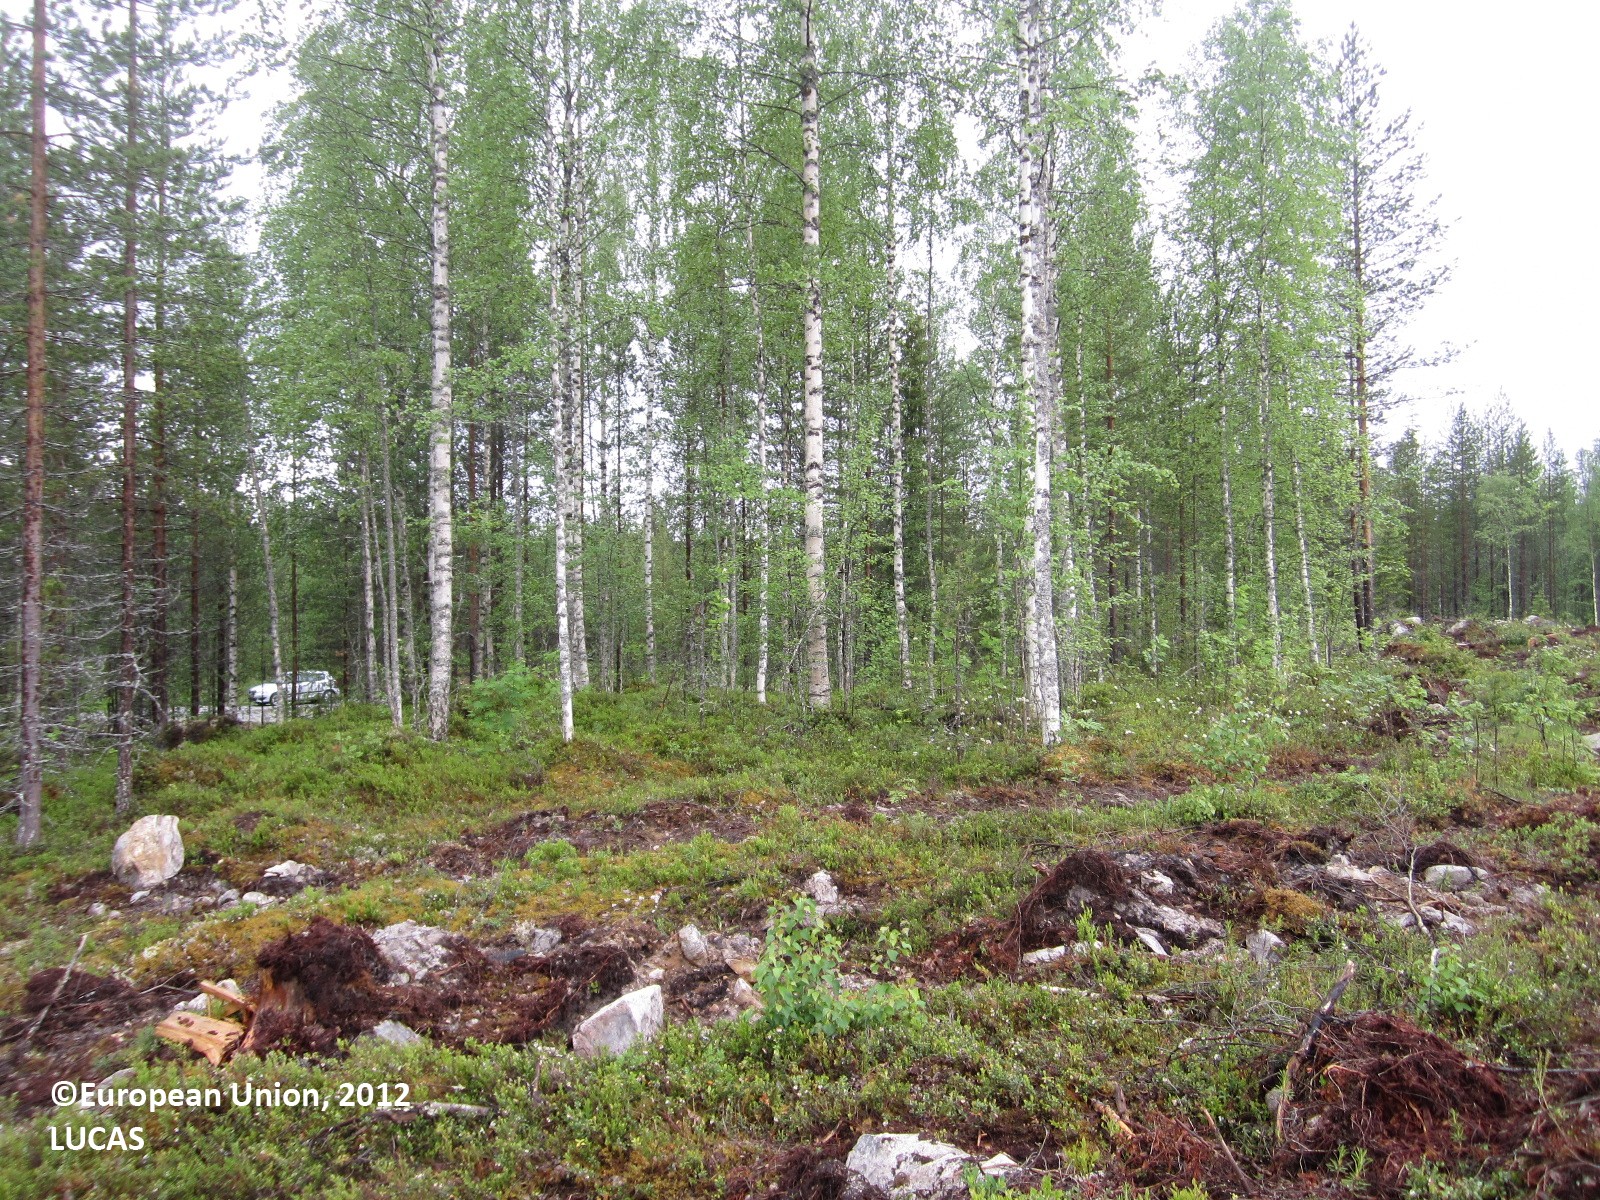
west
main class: Shrubland
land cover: Shrubland with sparse tree cover
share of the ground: 10 - 25 %
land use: Forestry
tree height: < 5 m
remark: Clear cut
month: June
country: FI
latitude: 64.2809
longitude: 29.4425
